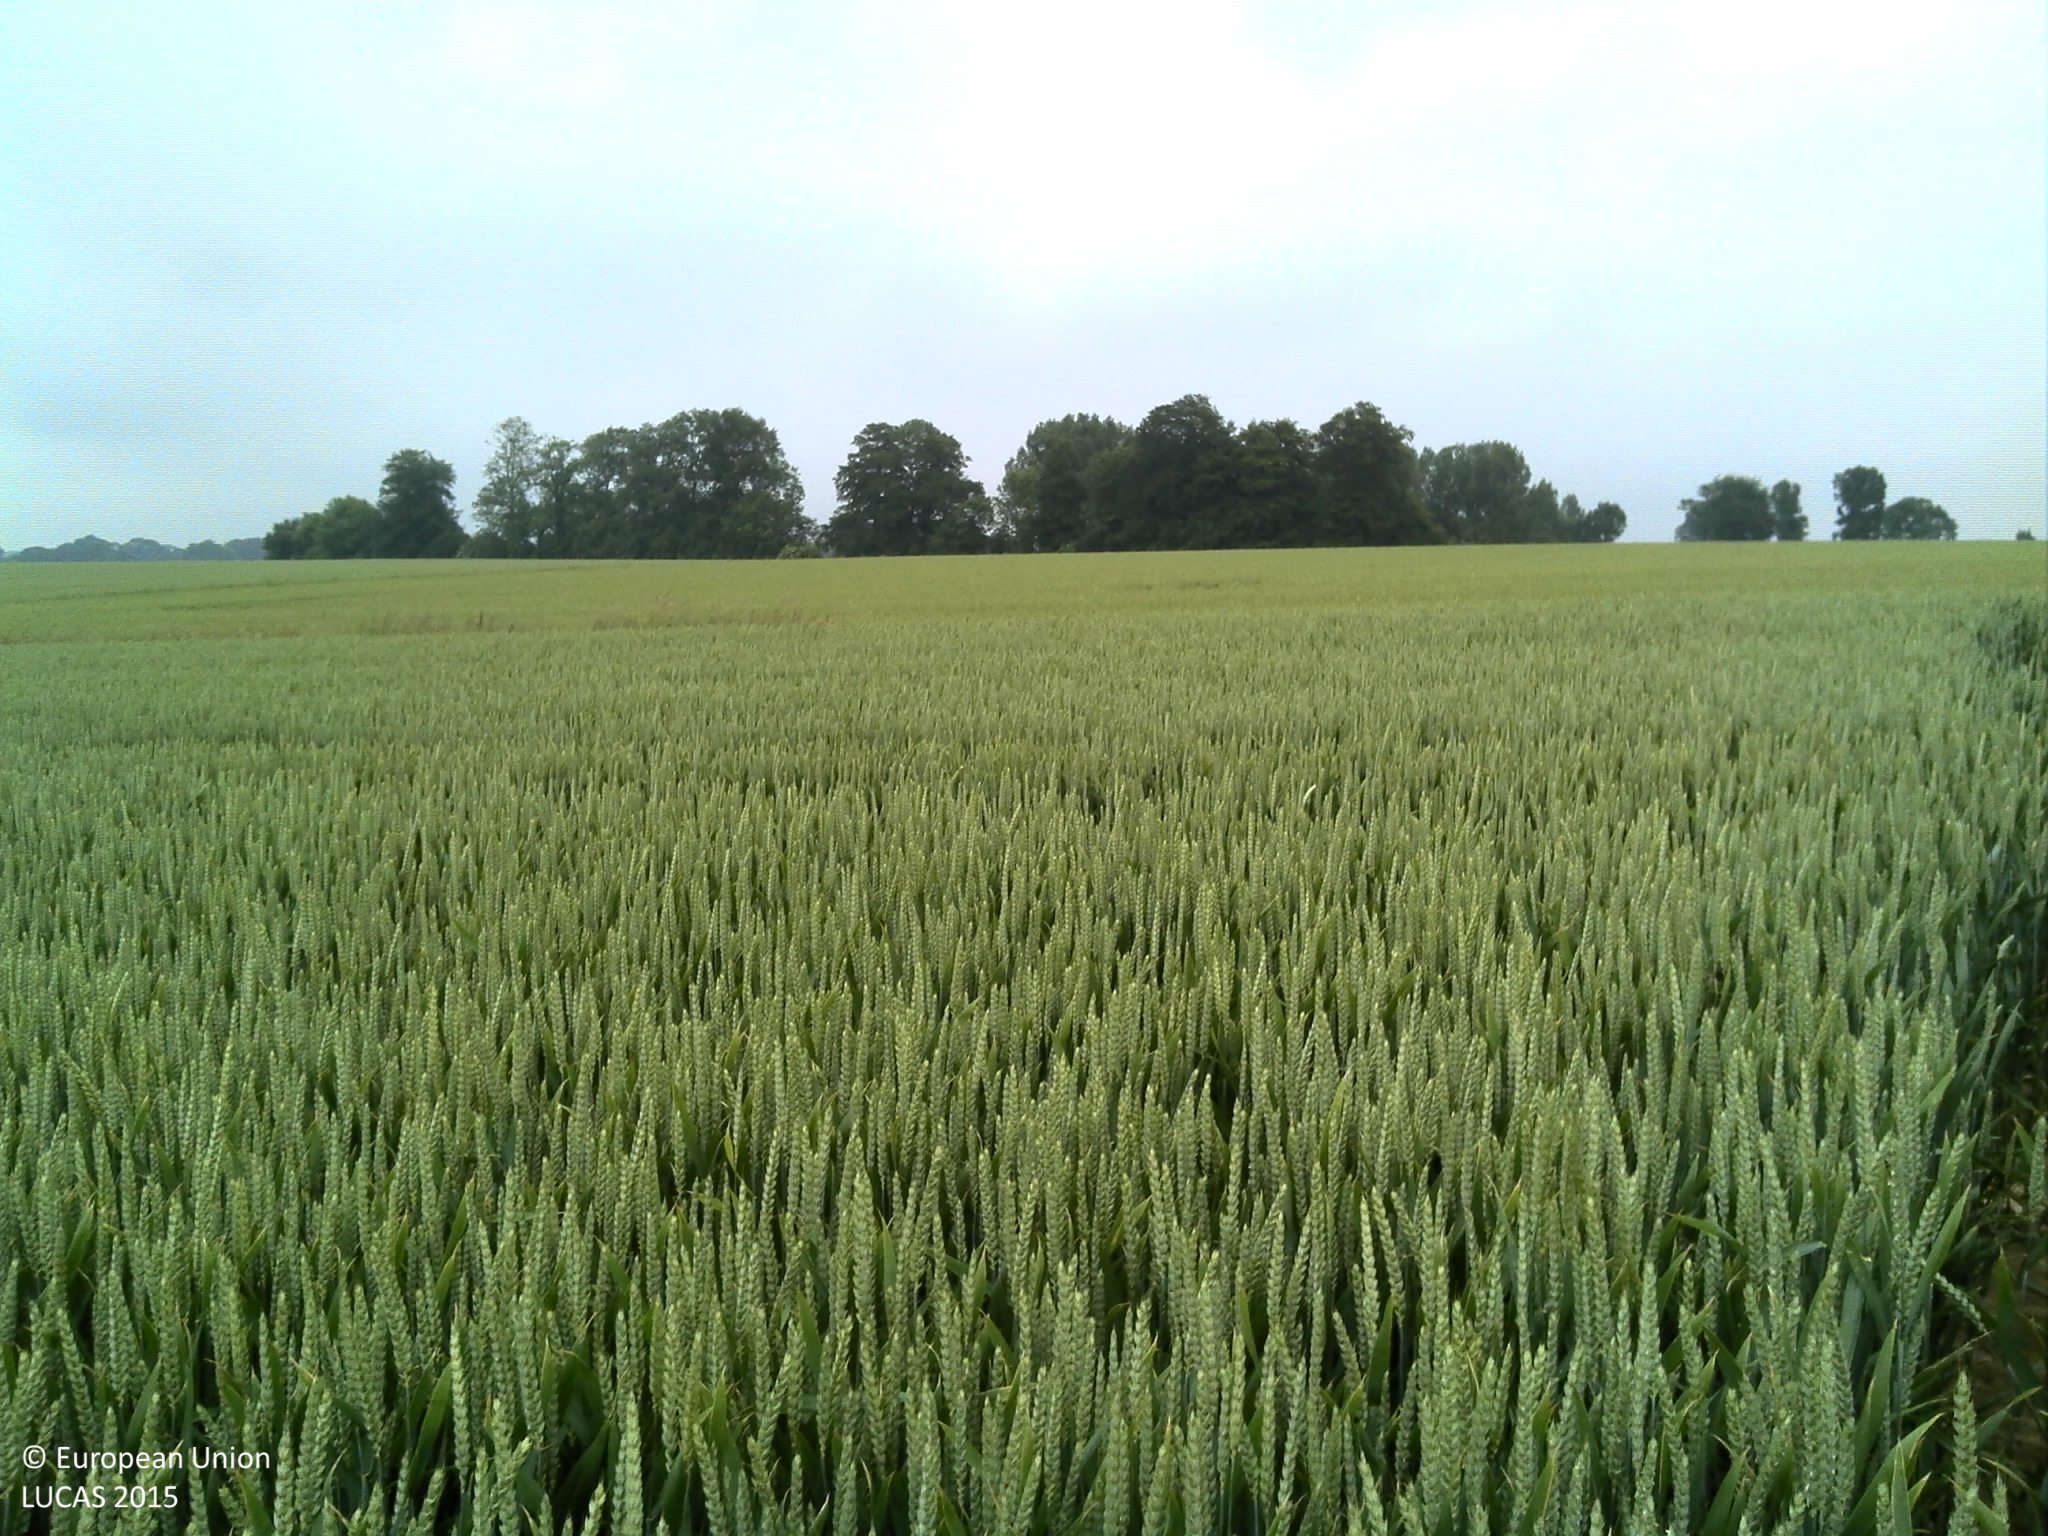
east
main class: Cropland
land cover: Common wheat
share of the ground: > 75 %
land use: Agriculture (excluding fallow land and kitchen gardens)
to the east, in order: Common wheat; Grass margins; Paved roads, cycling and walking lanes; Grass margins; Durum wheat; Common wheat
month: June
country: FR
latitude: 49.6493
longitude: 0.3737
